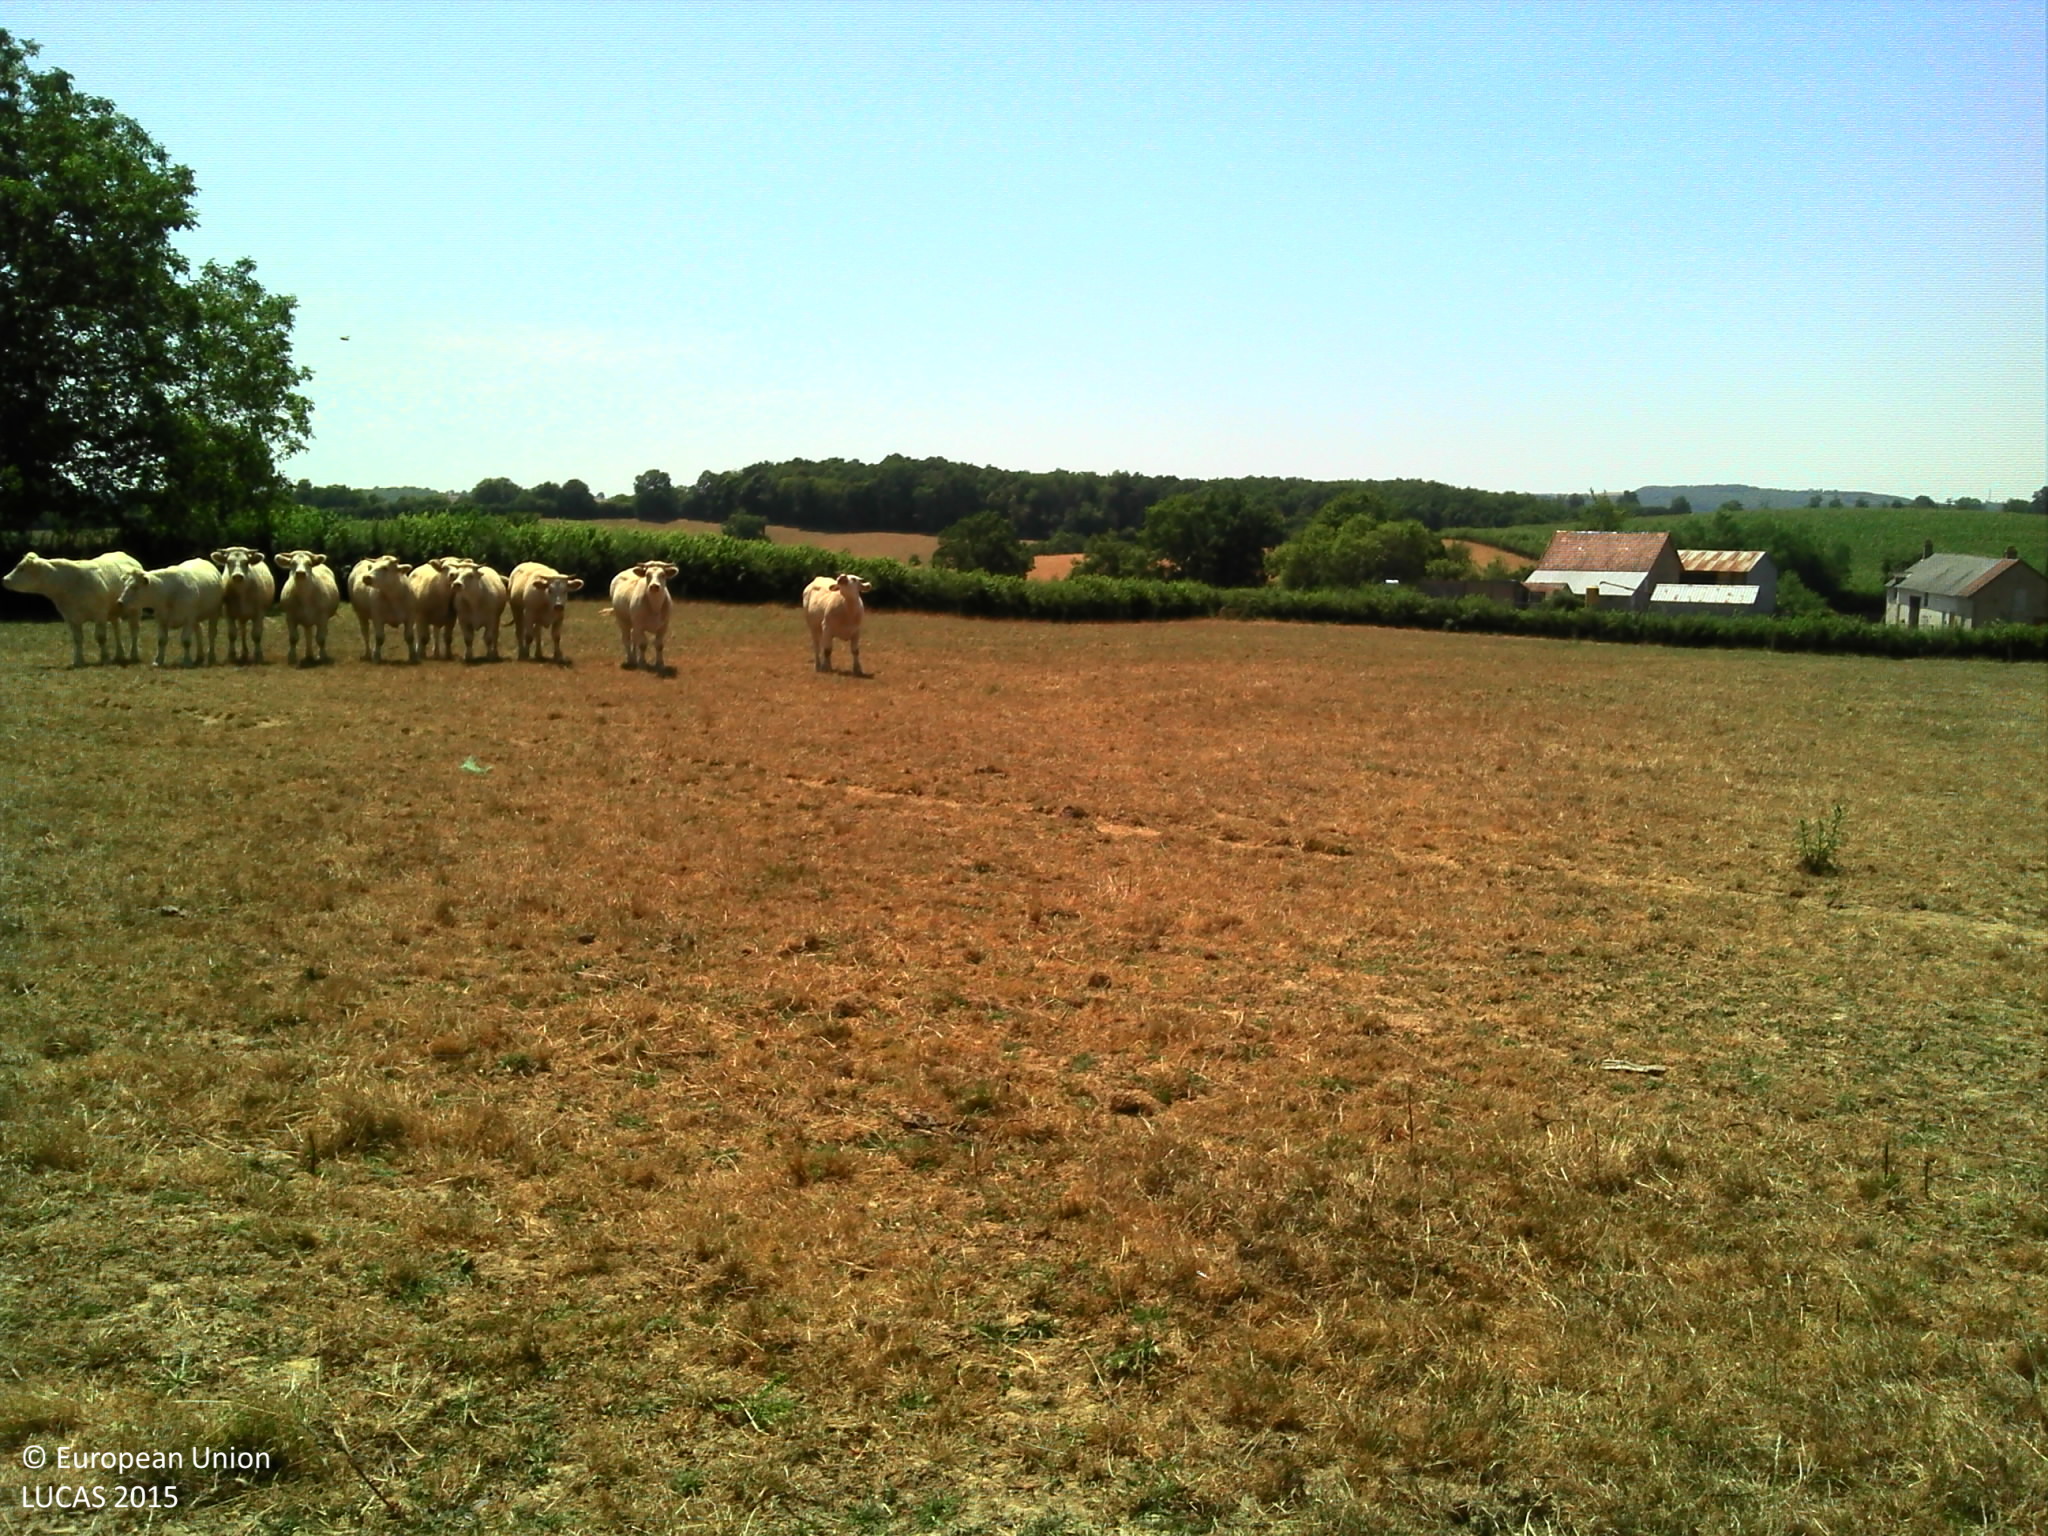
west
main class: Grassland
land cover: Grassland without tree/shrub cover
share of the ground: > 75 %
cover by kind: herbaceous plants 100 %
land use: Agriculture (excluding fallow land and kitchen gardens)
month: July
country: FR
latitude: 46.7974
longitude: 4.0120
